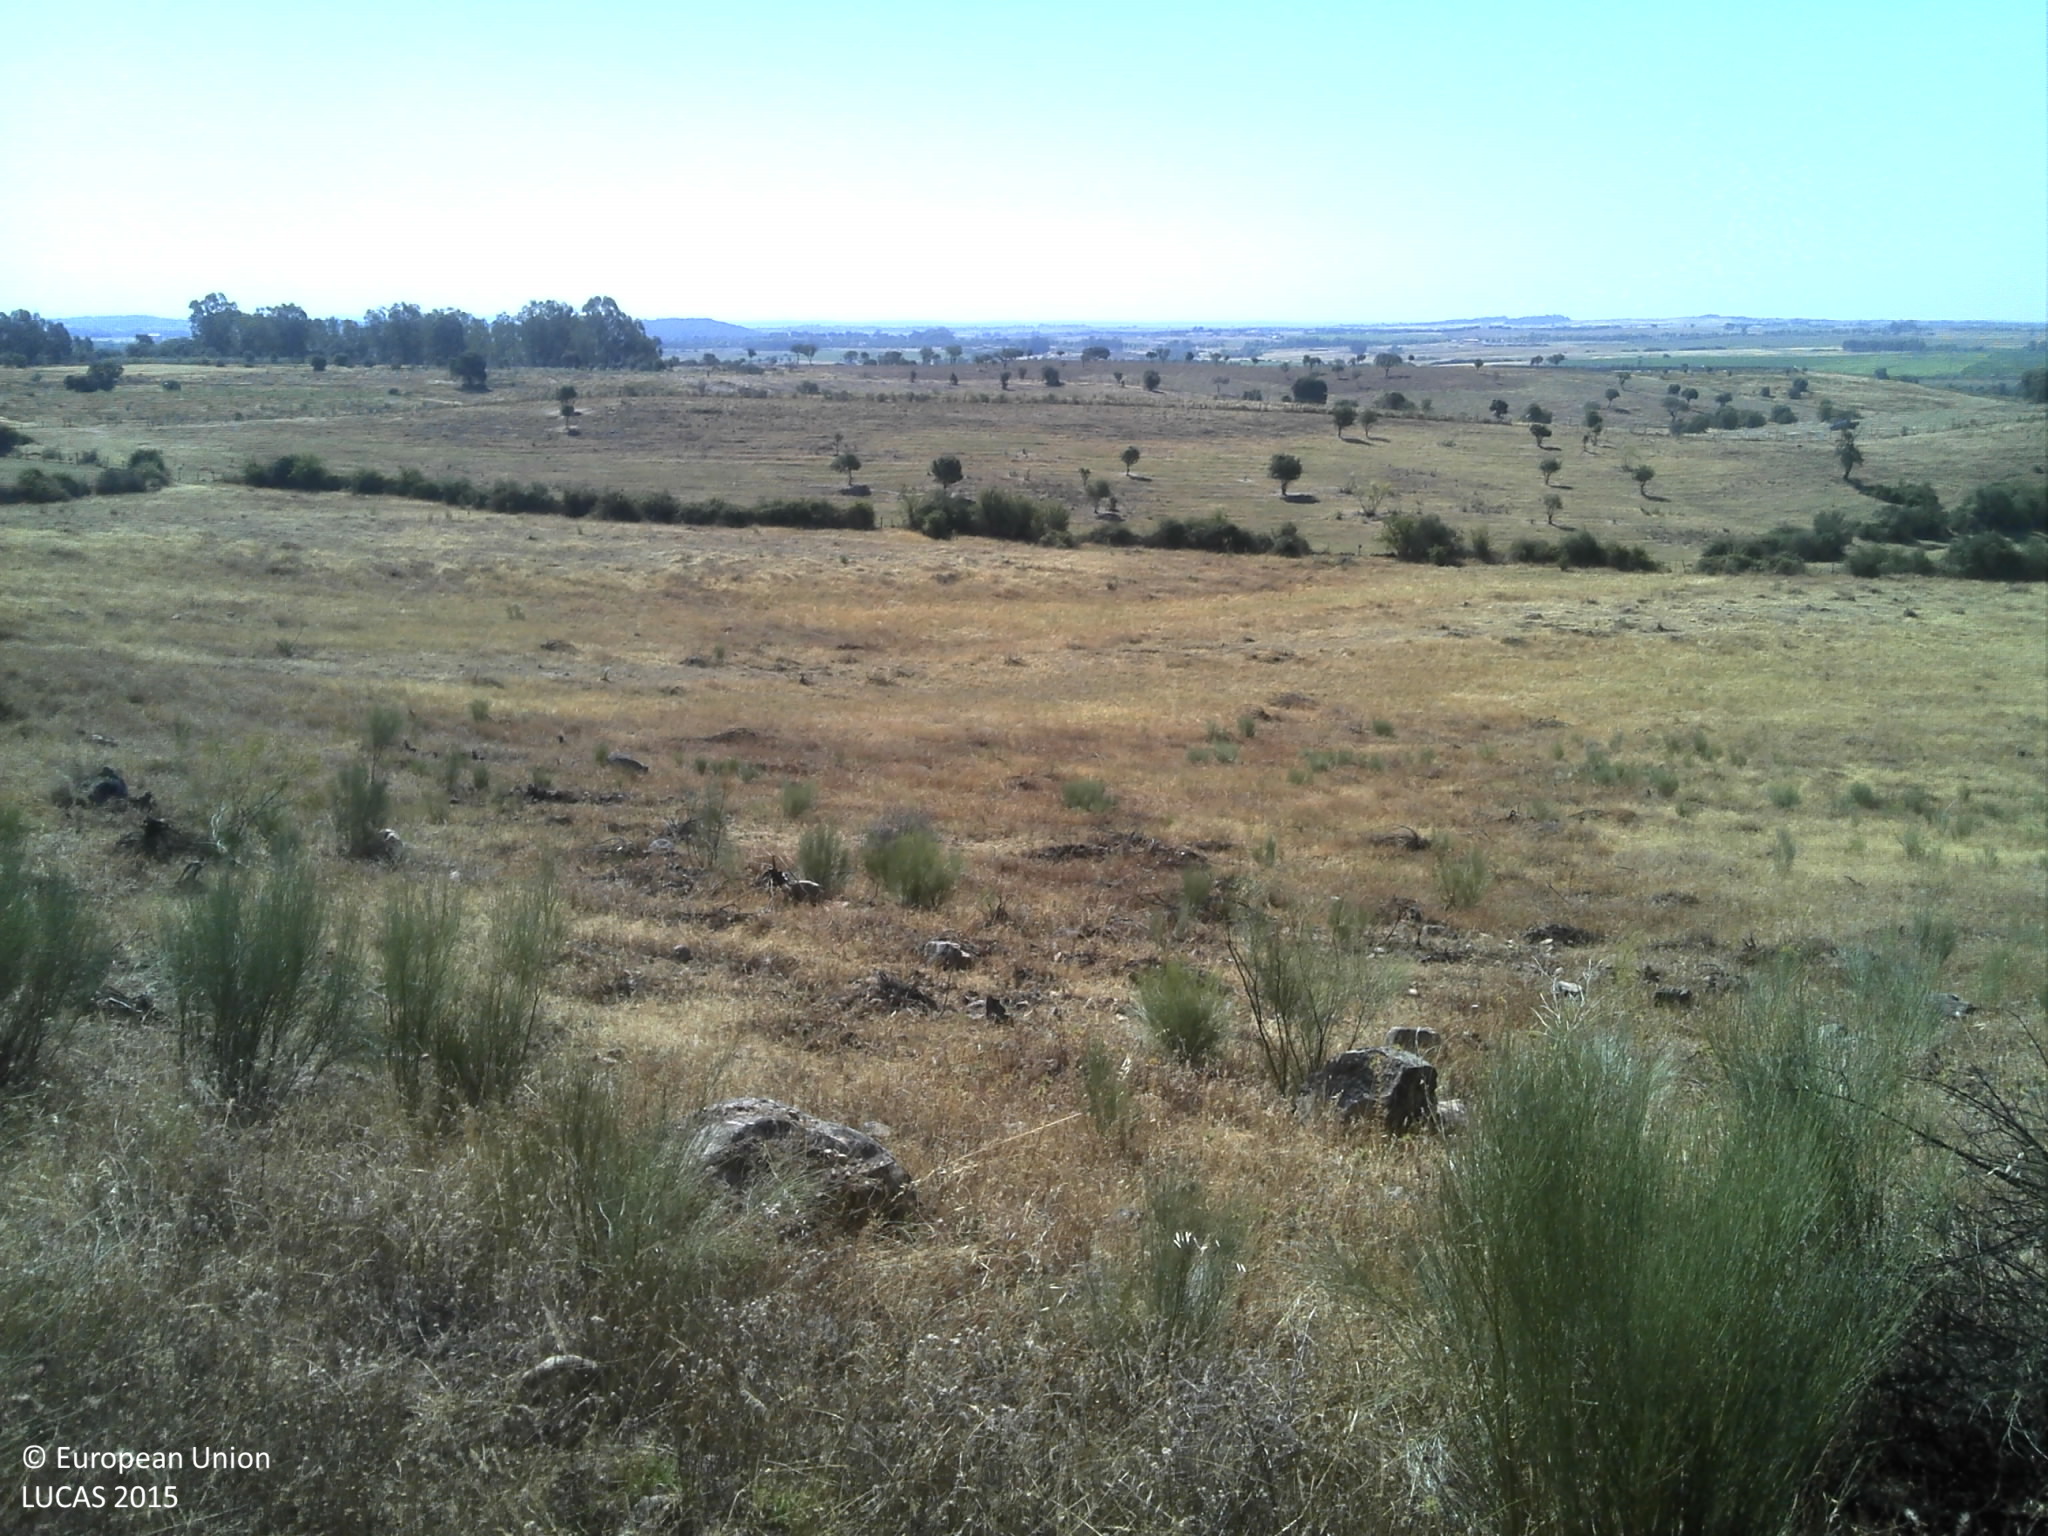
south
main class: Shrubland
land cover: Shrubland with sparse tree cover
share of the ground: 25 - 50 %
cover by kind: shrubs 30 %, herbaceous plants 30 %, unconsolidated bare surface 30 %, broadleaved forest trees 5 %
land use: Agriculture (excluding fallow land and kitchen gardens)
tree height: < 5 m
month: June
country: PT
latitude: 39.9022
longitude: -7.2776
